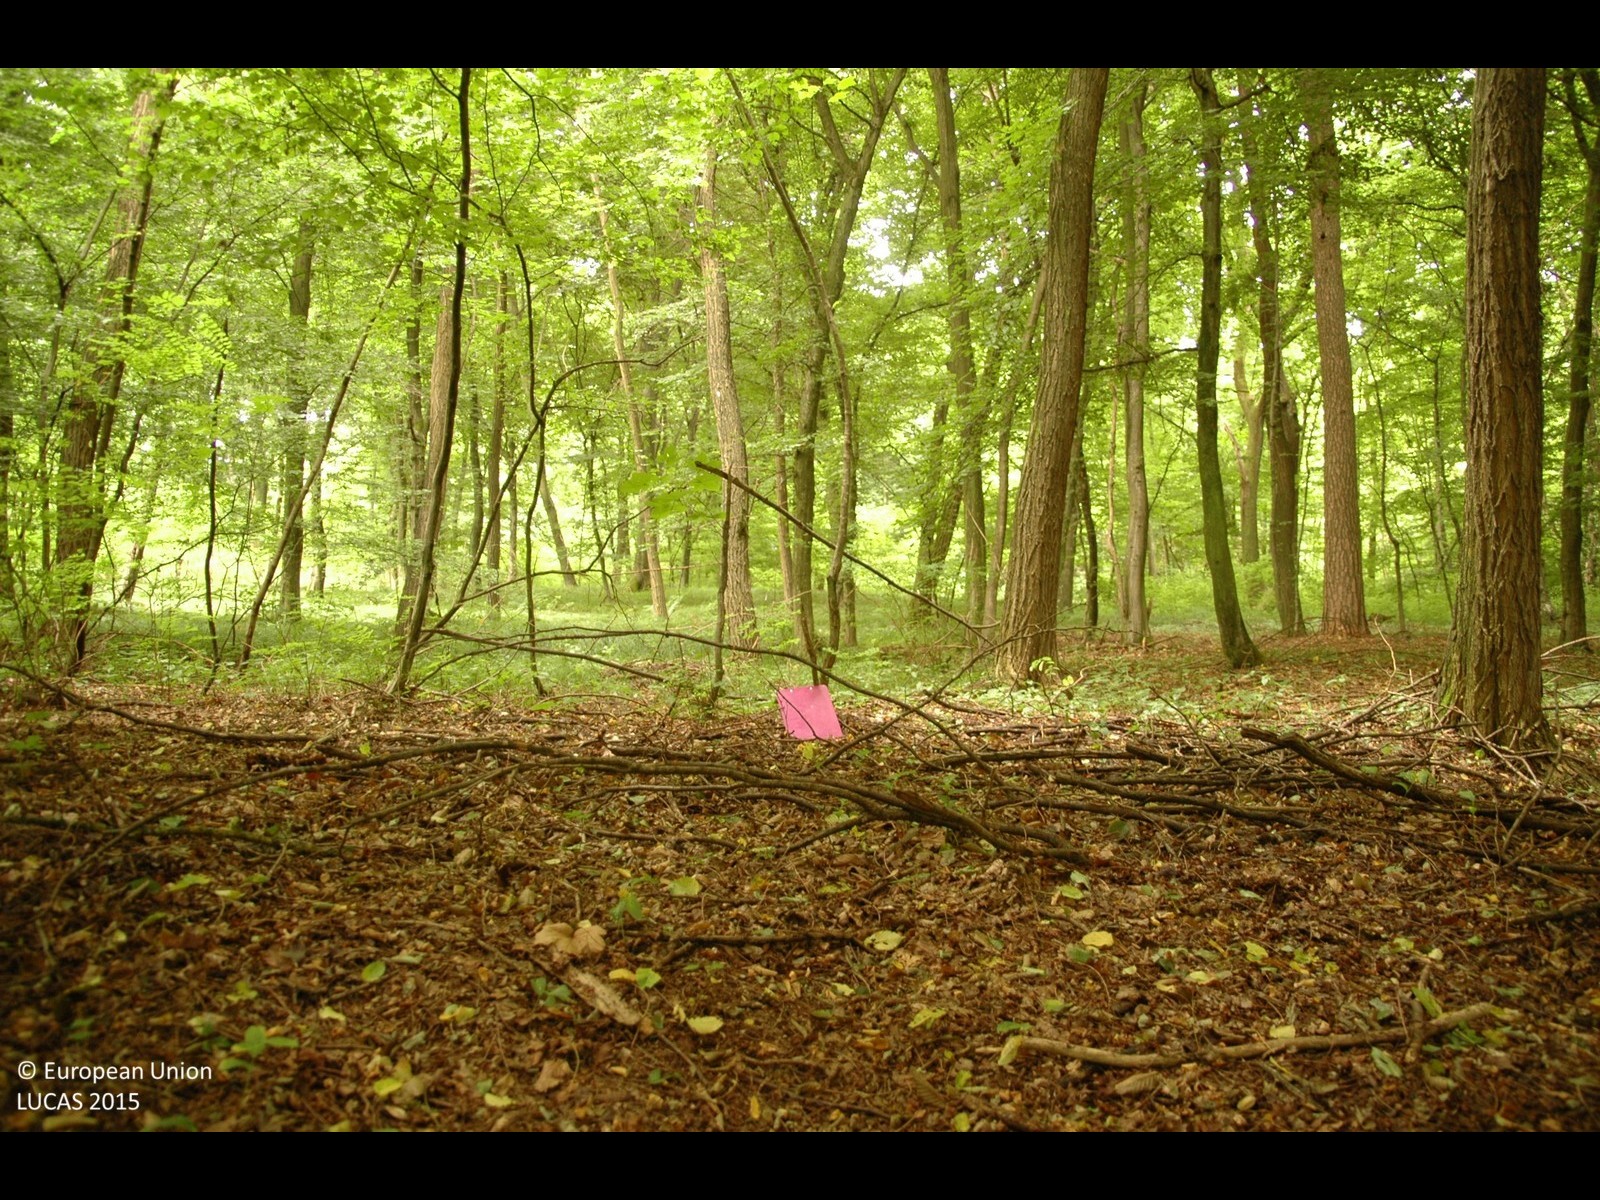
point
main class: Woodland
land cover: Broadleaved woodland
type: mesophytic deciduous forest
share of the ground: > 75 %
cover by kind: broadleaved forest trees 100 %
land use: Forestry
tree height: > 5 m
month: July
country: HR
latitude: 46.4310
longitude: 16.3904
